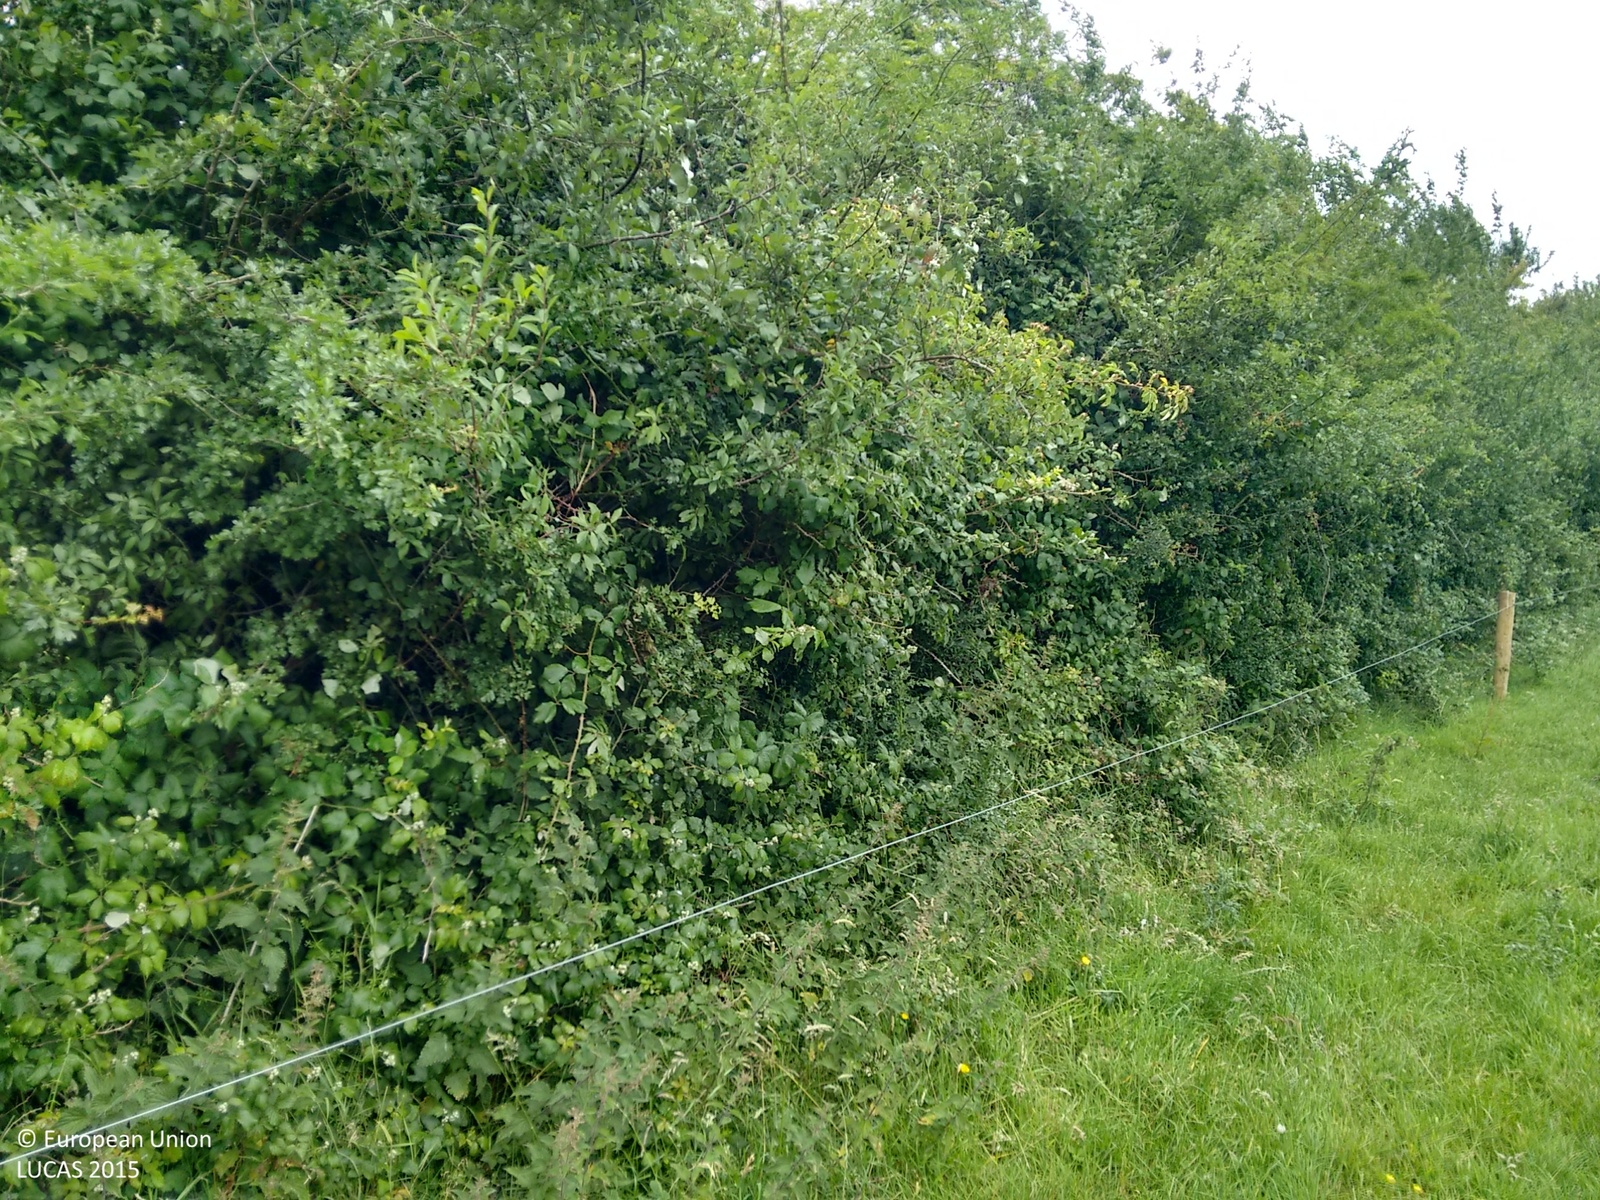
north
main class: Grassland
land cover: Grassland without tree/shrub cover
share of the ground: > 75 %
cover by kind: herbaceous plants 95 %, unconsolidated bare surface 5 %
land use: Agriculture (excluding fallow land and kitchen gardens)
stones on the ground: < 10 %
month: July
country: IE
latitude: 52.6780
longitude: -7.5392
